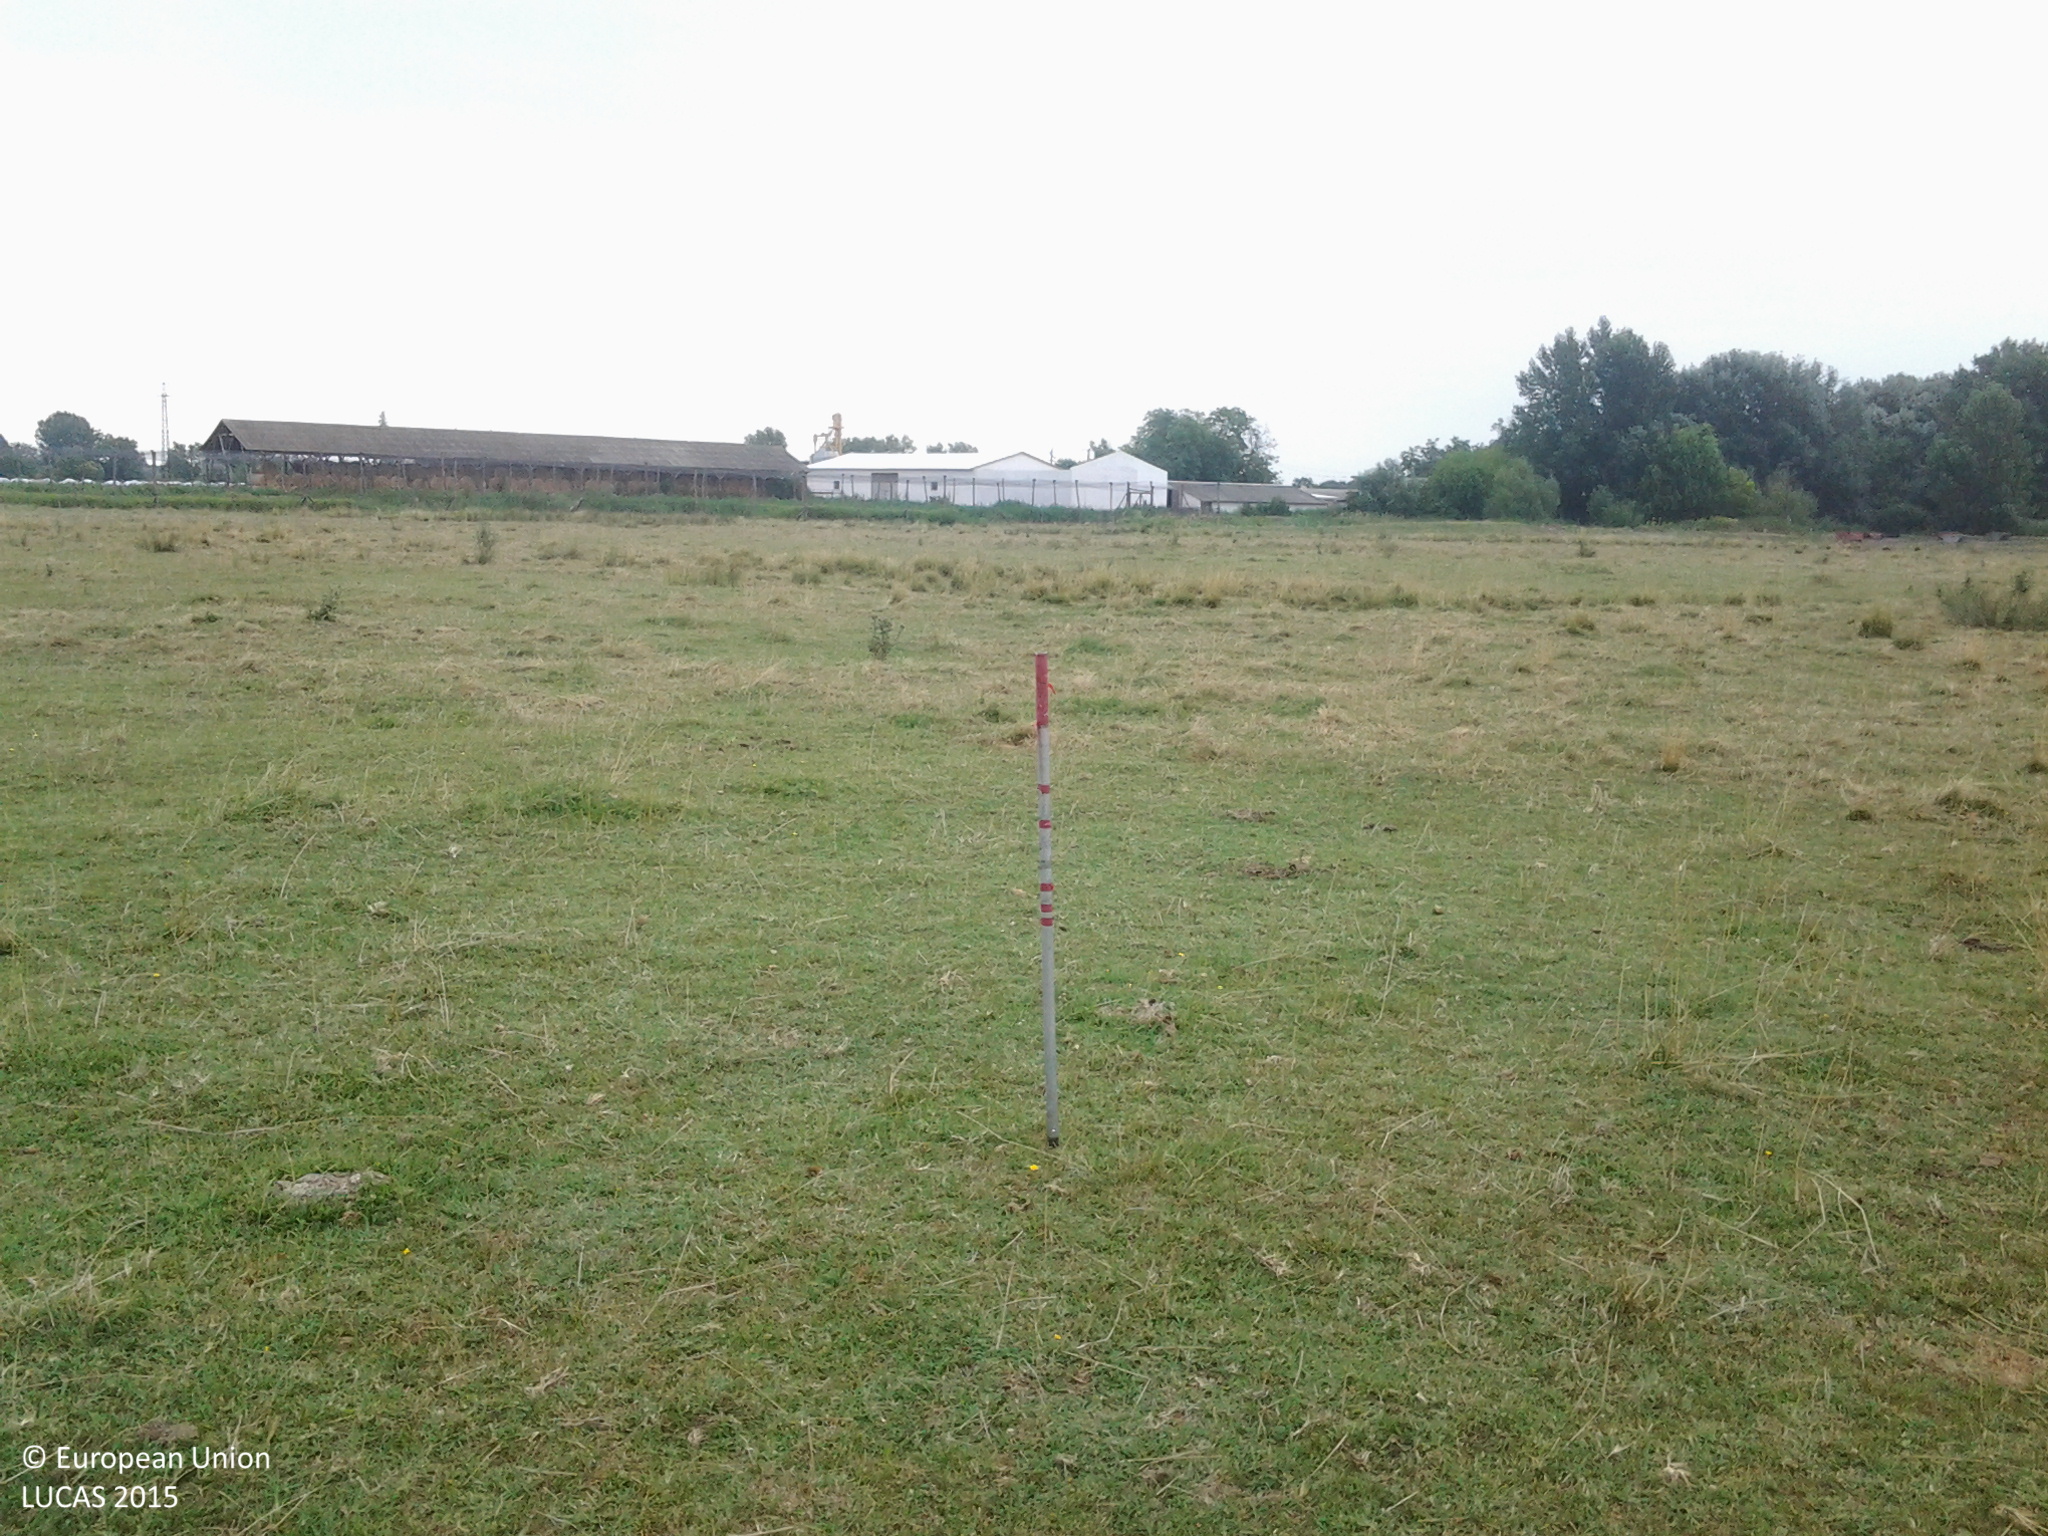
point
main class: Grassland
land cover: Grassland without tree/shrub cover
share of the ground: > 75 %
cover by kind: herbaceous plants 100 %
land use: Agriculture (excluding fallow land and kitchen gardens)
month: July
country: HU
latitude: 46.6381
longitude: 19.2518
